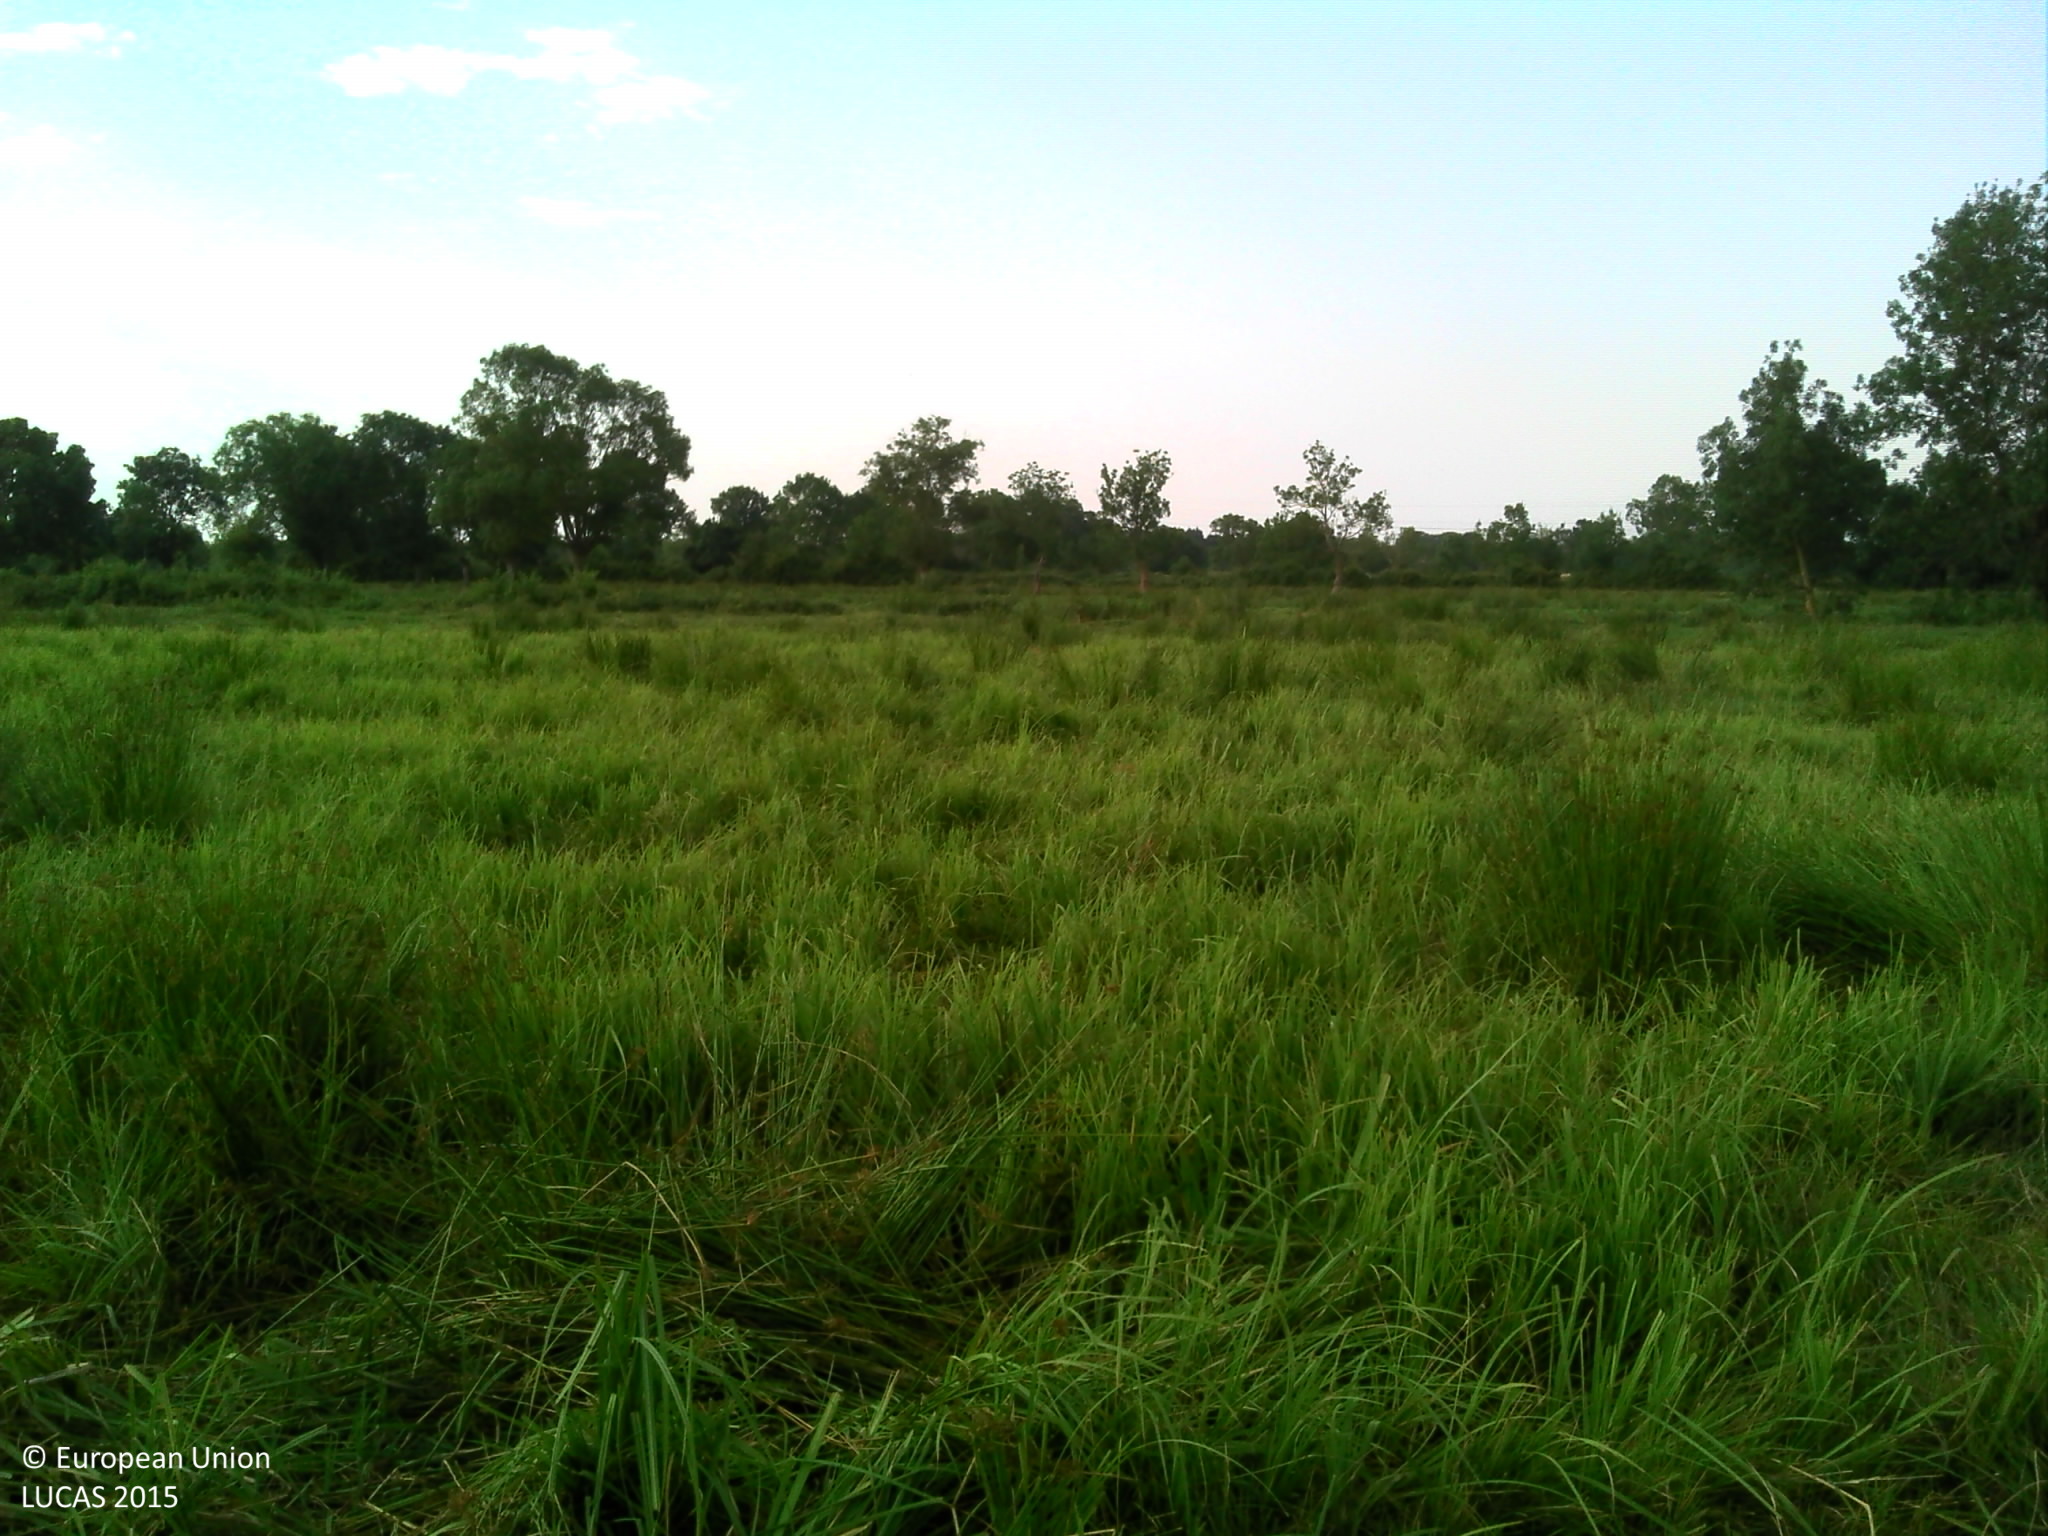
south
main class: Grassland
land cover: Grassland without tree/shrub cover
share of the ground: > 75 %
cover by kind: herbaceous plants 100 %
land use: Agriculture (excluding fallow land and kitchen gardens)
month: July
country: FR
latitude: 47.2903
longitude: -1.8545
